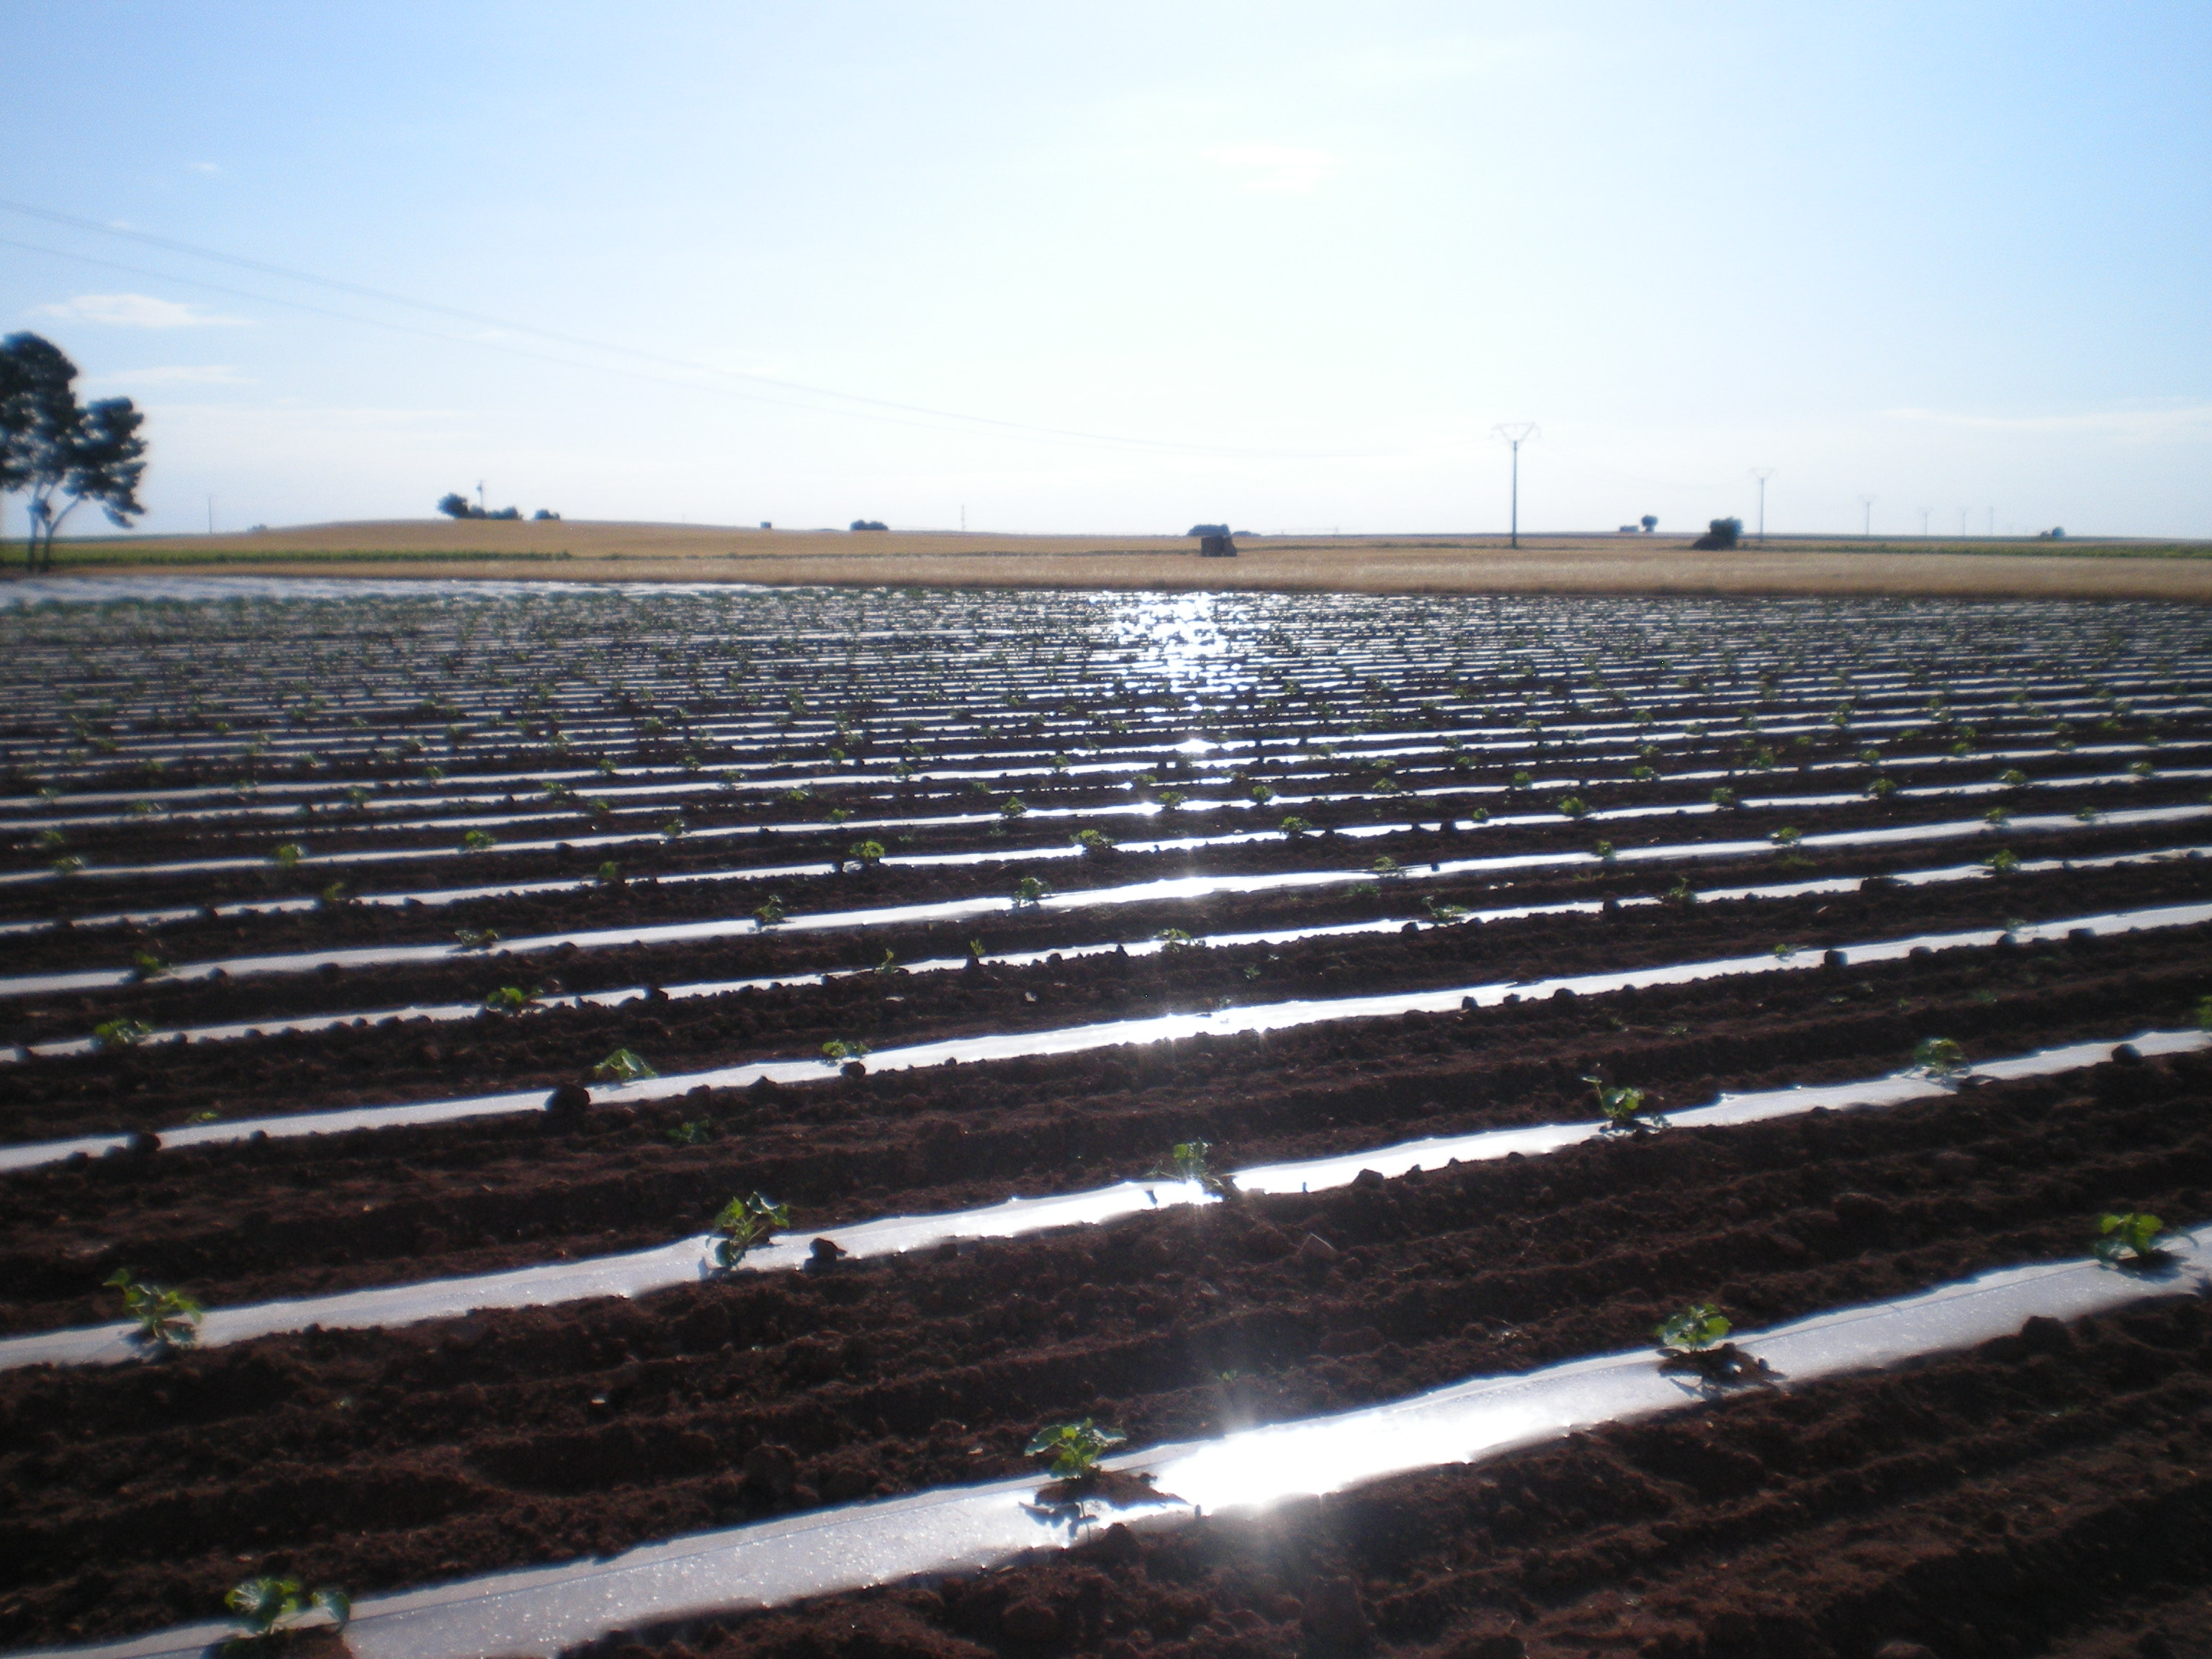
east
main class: Cropland
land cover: Other fresh vegetables
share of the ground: < 10 %
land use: Agriculture (excluding fallow land and kitchen gardens)
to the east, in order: Other fresh vegetables; Tracks; Grass margins; Barley
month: May
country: ES
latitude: 39.0398
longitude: -3.4754
